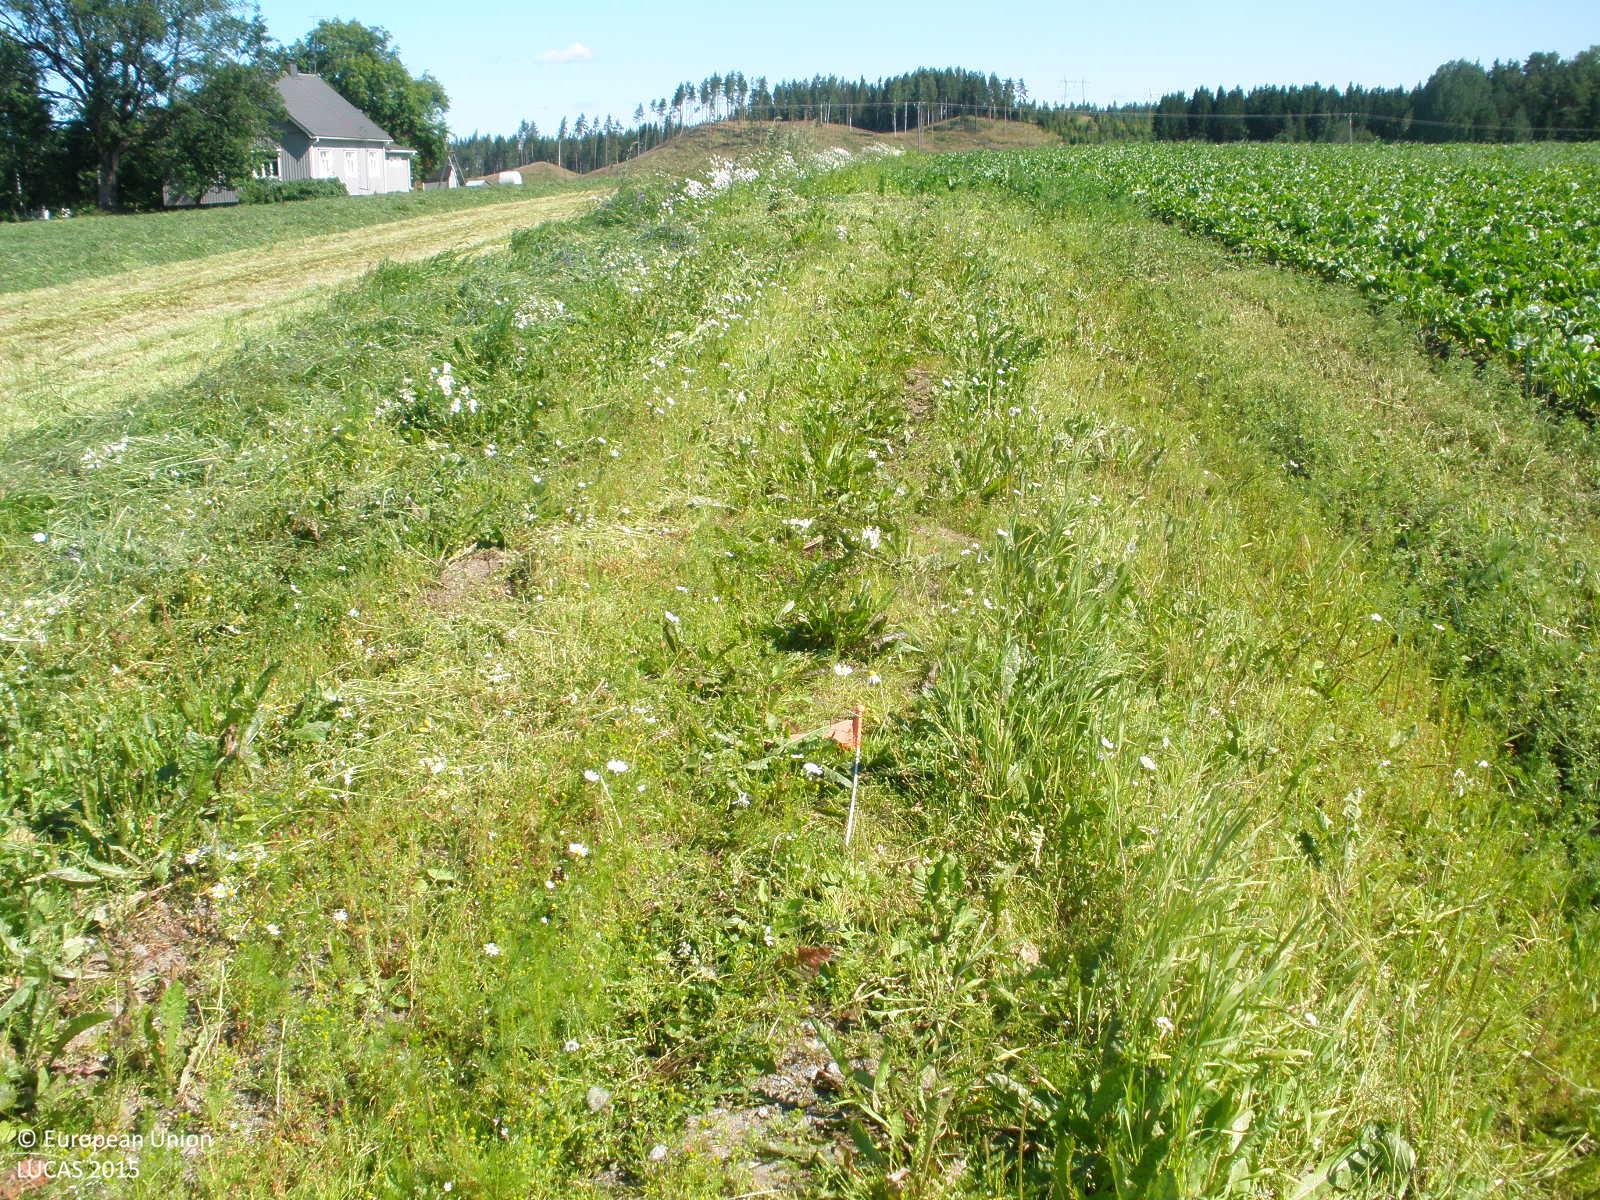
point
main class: Artificial land
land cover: Non built-up linear features
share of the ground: > 75 %
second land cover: Grassland without tree/shrub cover
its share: > 75 %
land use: Road transport
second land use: Agriculture (excluding fallow land and kitchen gardens)
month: July
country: FI
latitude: 61.0717
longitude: 24.9186
